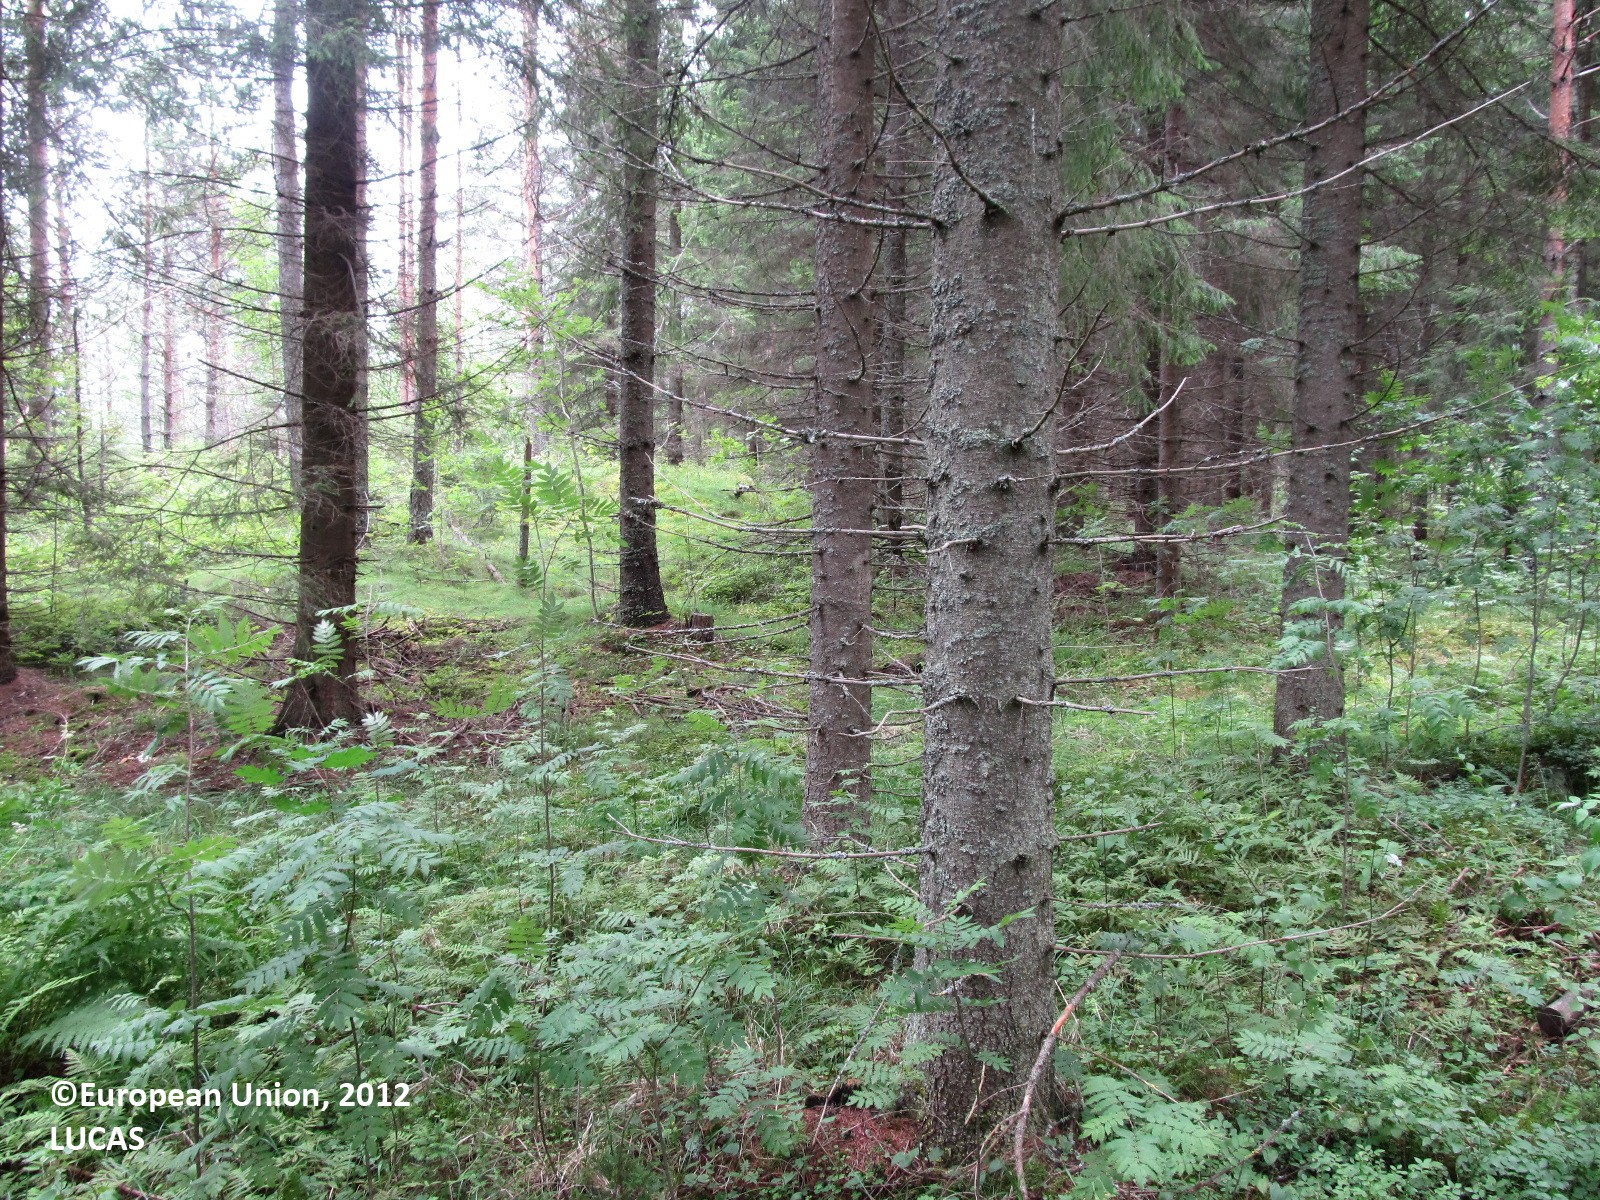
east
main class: Woodland
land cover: Spruce dominated coniferous woodland
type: boreal forest
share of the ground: 50 - 75 %
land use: Forestry
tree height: > 5 m
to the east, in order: Spruce dominated coniferous woodland; Tracks; Ditches and canals; Spruce dominated coniferous woodland; Fences; Temporary grasslands
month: July
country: FI
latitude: 61.8989
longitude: 29.0499
